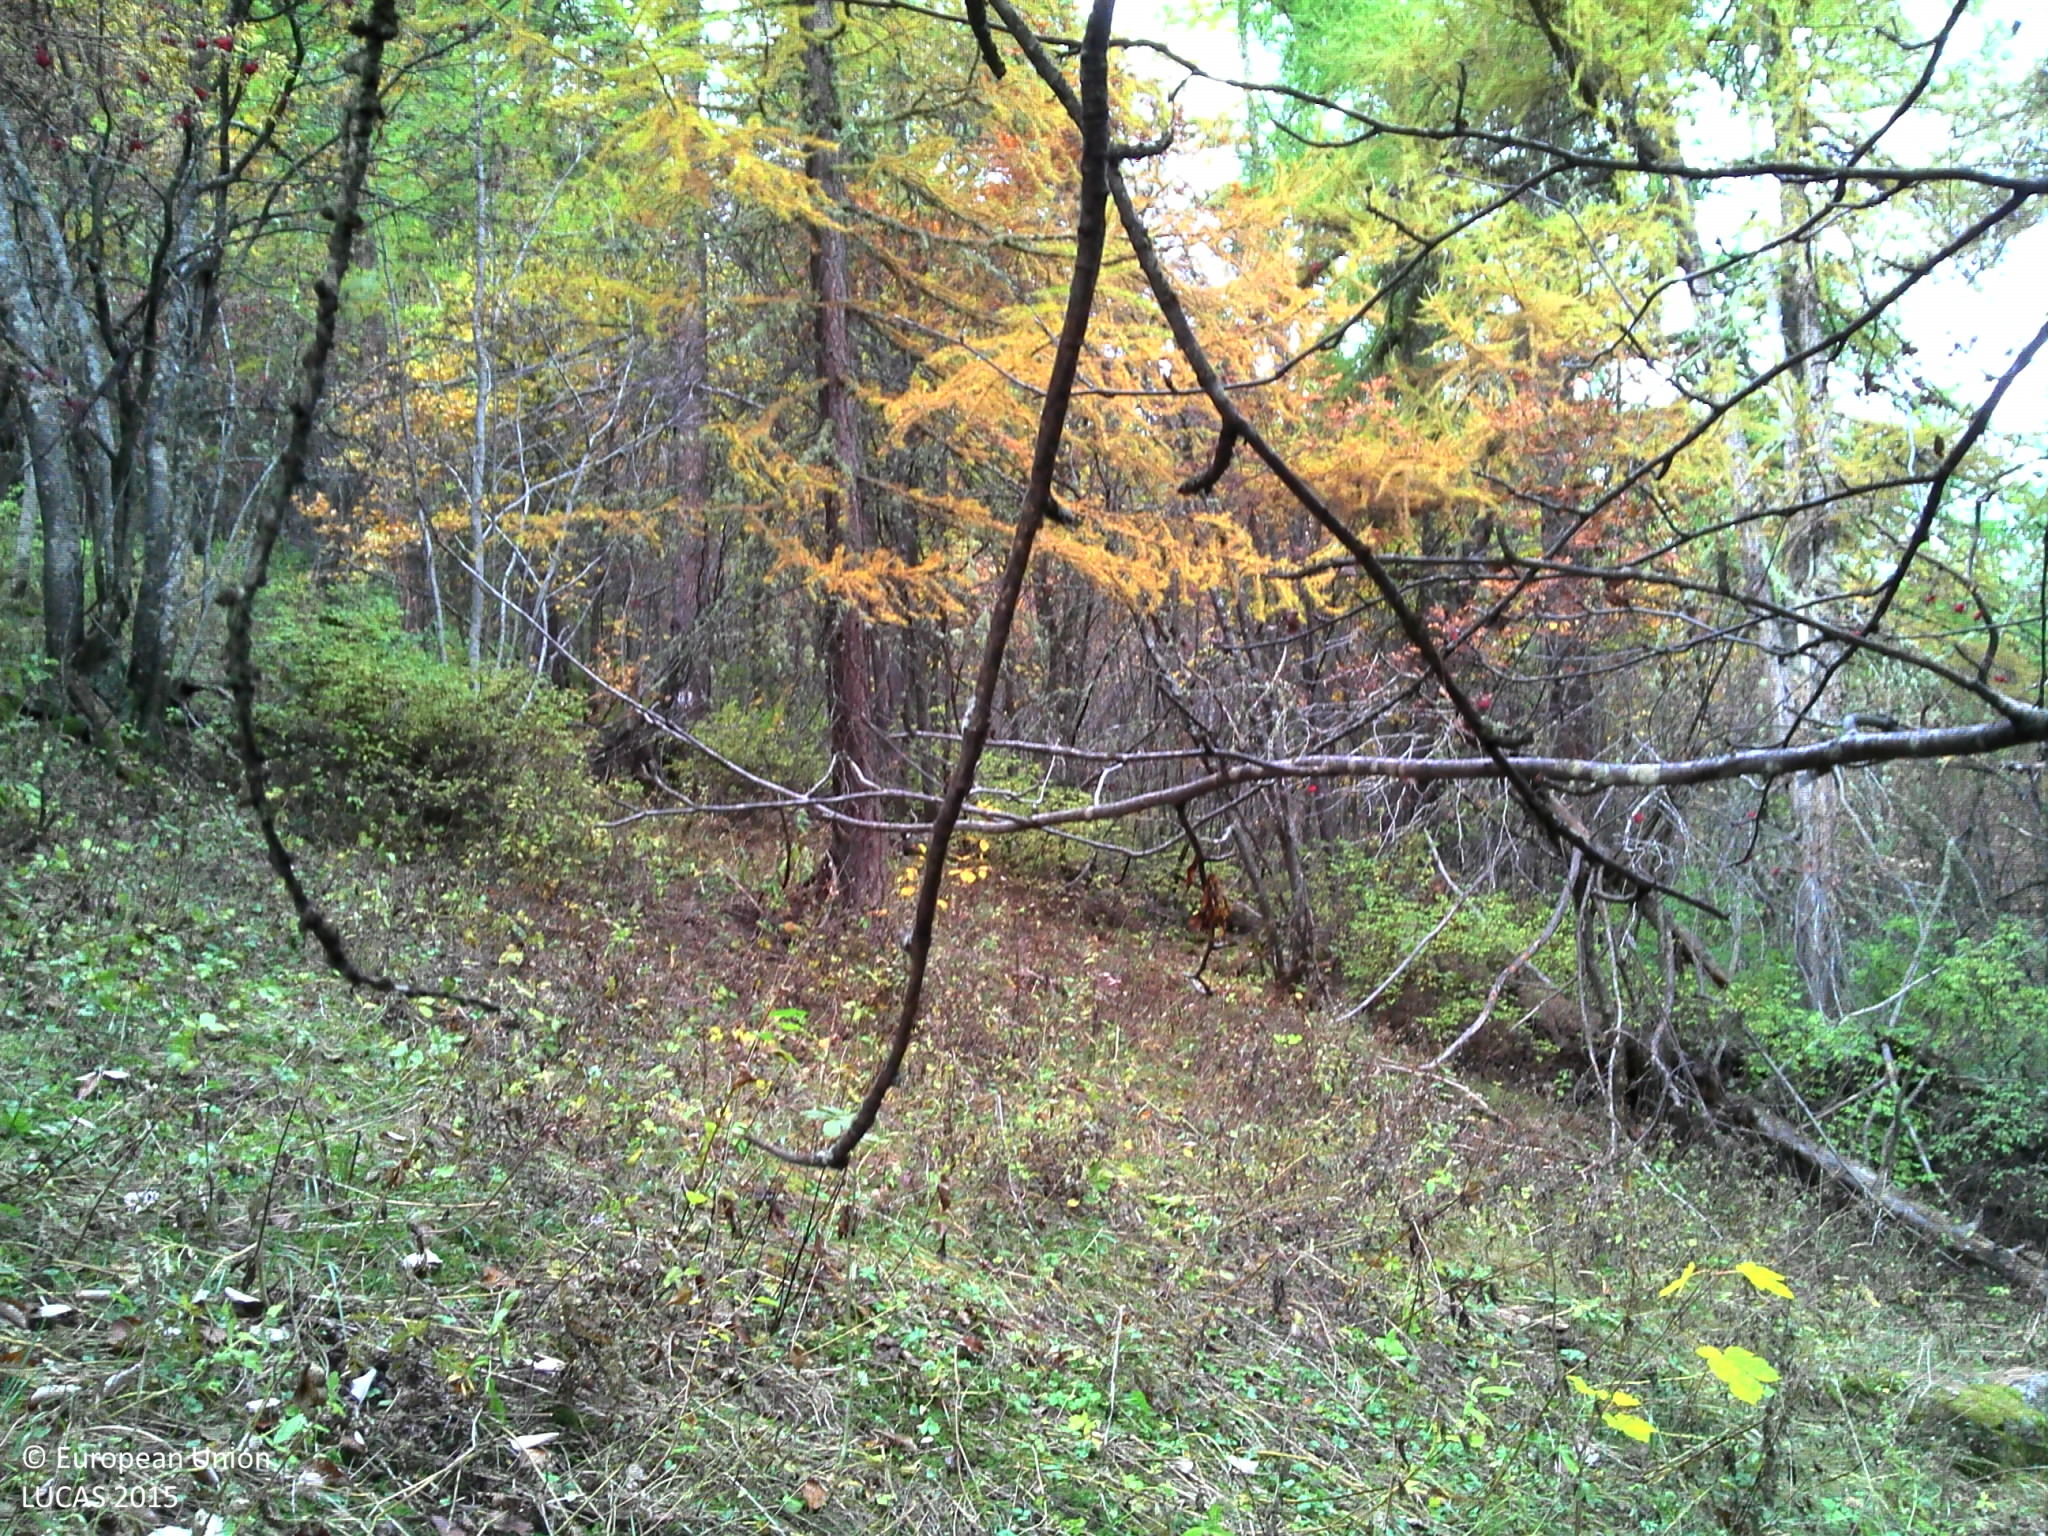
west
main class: Woodland
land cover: Pine dominated mixed woodland
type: hemiboreal forest and nemoral coniferous forest and mixed broadleaved-coniferous forest
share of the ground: > 75 %
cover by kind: coniferous forest trees 35 %, broadleaved forest trees 25 %, shrubs 20 %, herbaceous plants 15 %, consolidated bare surface 5 %
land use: Forestry
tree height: > 5 m
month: October
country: FR
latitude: 44.7799
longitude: 6.5305
